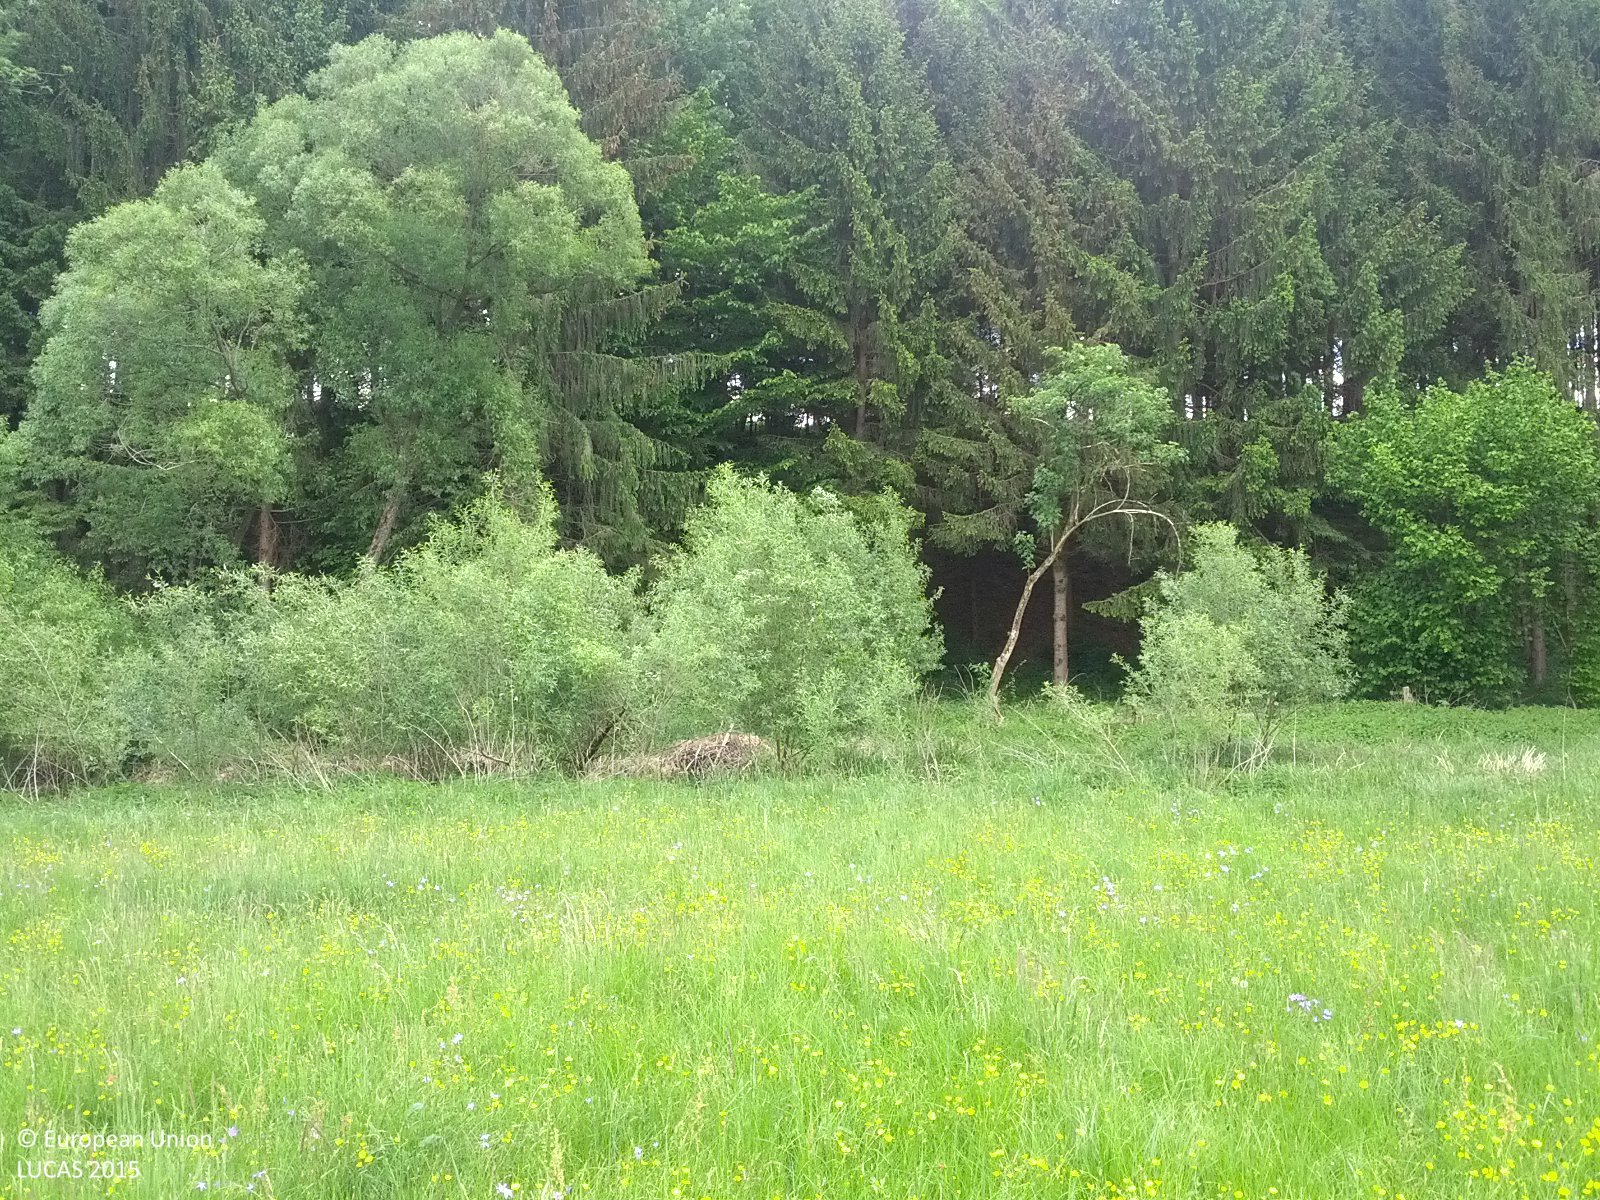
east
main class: Grassland
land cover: Grassland without tree/shrub cover
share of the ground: > 75 %
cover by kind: herbaceous plants 100 %
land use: Agriculture (excluding fallow land and kitchen gardens)
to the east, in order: Grassland without tree/shrub cover; Shruby margins; Fences; Broadleaved woodland; Tracks; Spruce dominated coniferous woodland; Broadleaved woodland; Other fresh vegetables; Maize
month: May
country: AT
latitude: 47.3355
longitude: 16.0499
